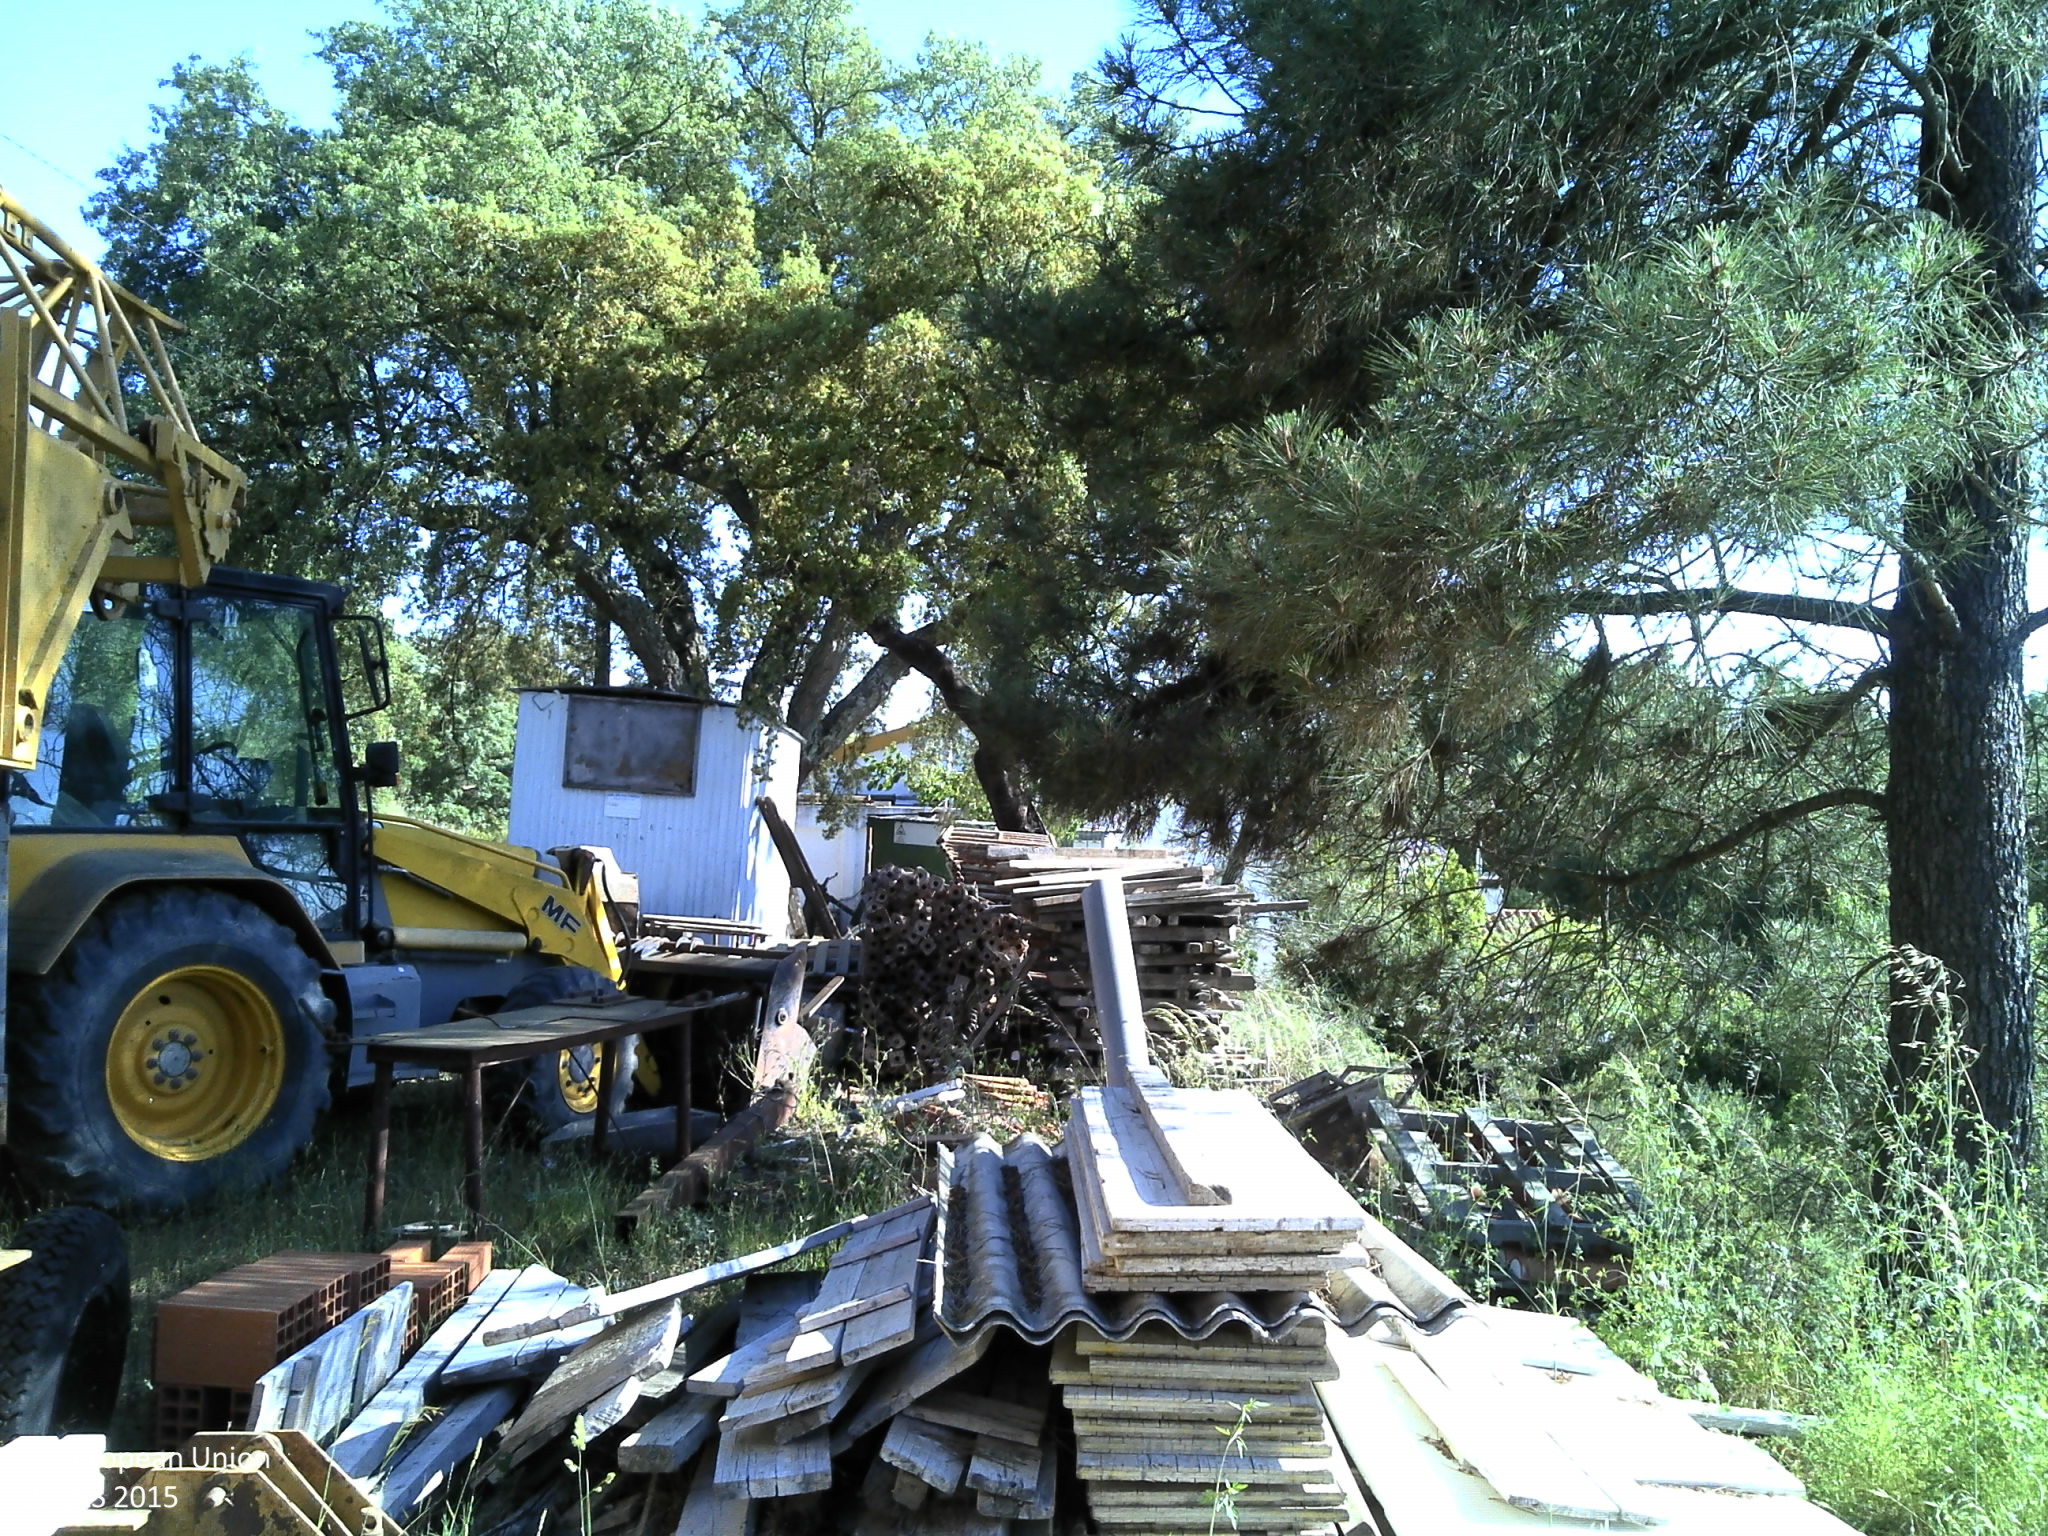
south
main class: Woodland
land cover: Pine dominated coniferous woodland
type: coniferous forest of the mediterranean region
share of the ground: 25 - 50 %
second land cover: Shrubland without tree cover
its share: 50 - 75 %
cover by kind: shrubs 50 %, coniferous forest trees 40 %, unconsolidated bare surface 10 %
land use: Abandoned areas
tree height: > 5 m
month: May
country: PT
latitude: 39.2516
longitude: -8.0043
